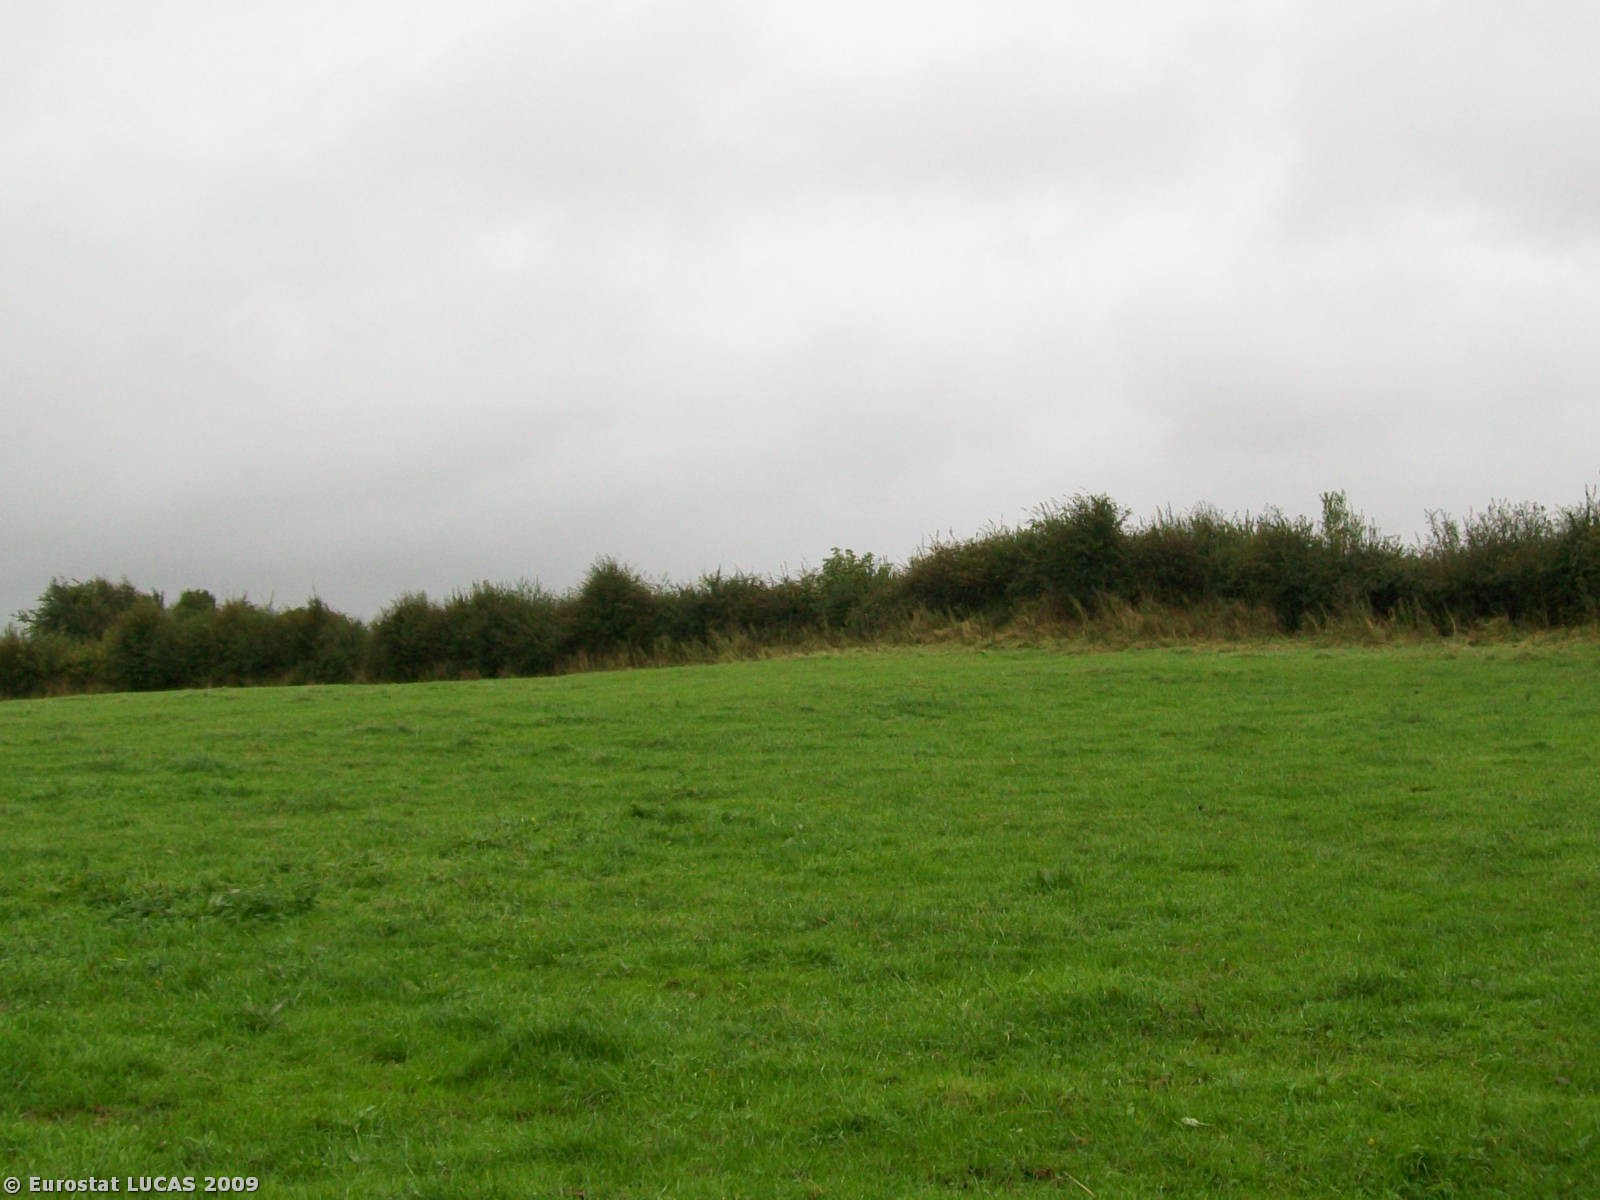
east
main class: Shrubland
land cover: Shrubland without tree cover
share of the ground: > 75 %
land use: Fallow land
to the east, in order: Shrubland without tree cover; Ditches and canals; Shrubland without tree cover; Grassland without tree/shrub cover; Fences; Grassland without tree/shrub cover; Managed hedges; Fences; Grassland without tree/shrub cover
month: September
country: IE
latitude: 53.1942
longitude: -7.9093
